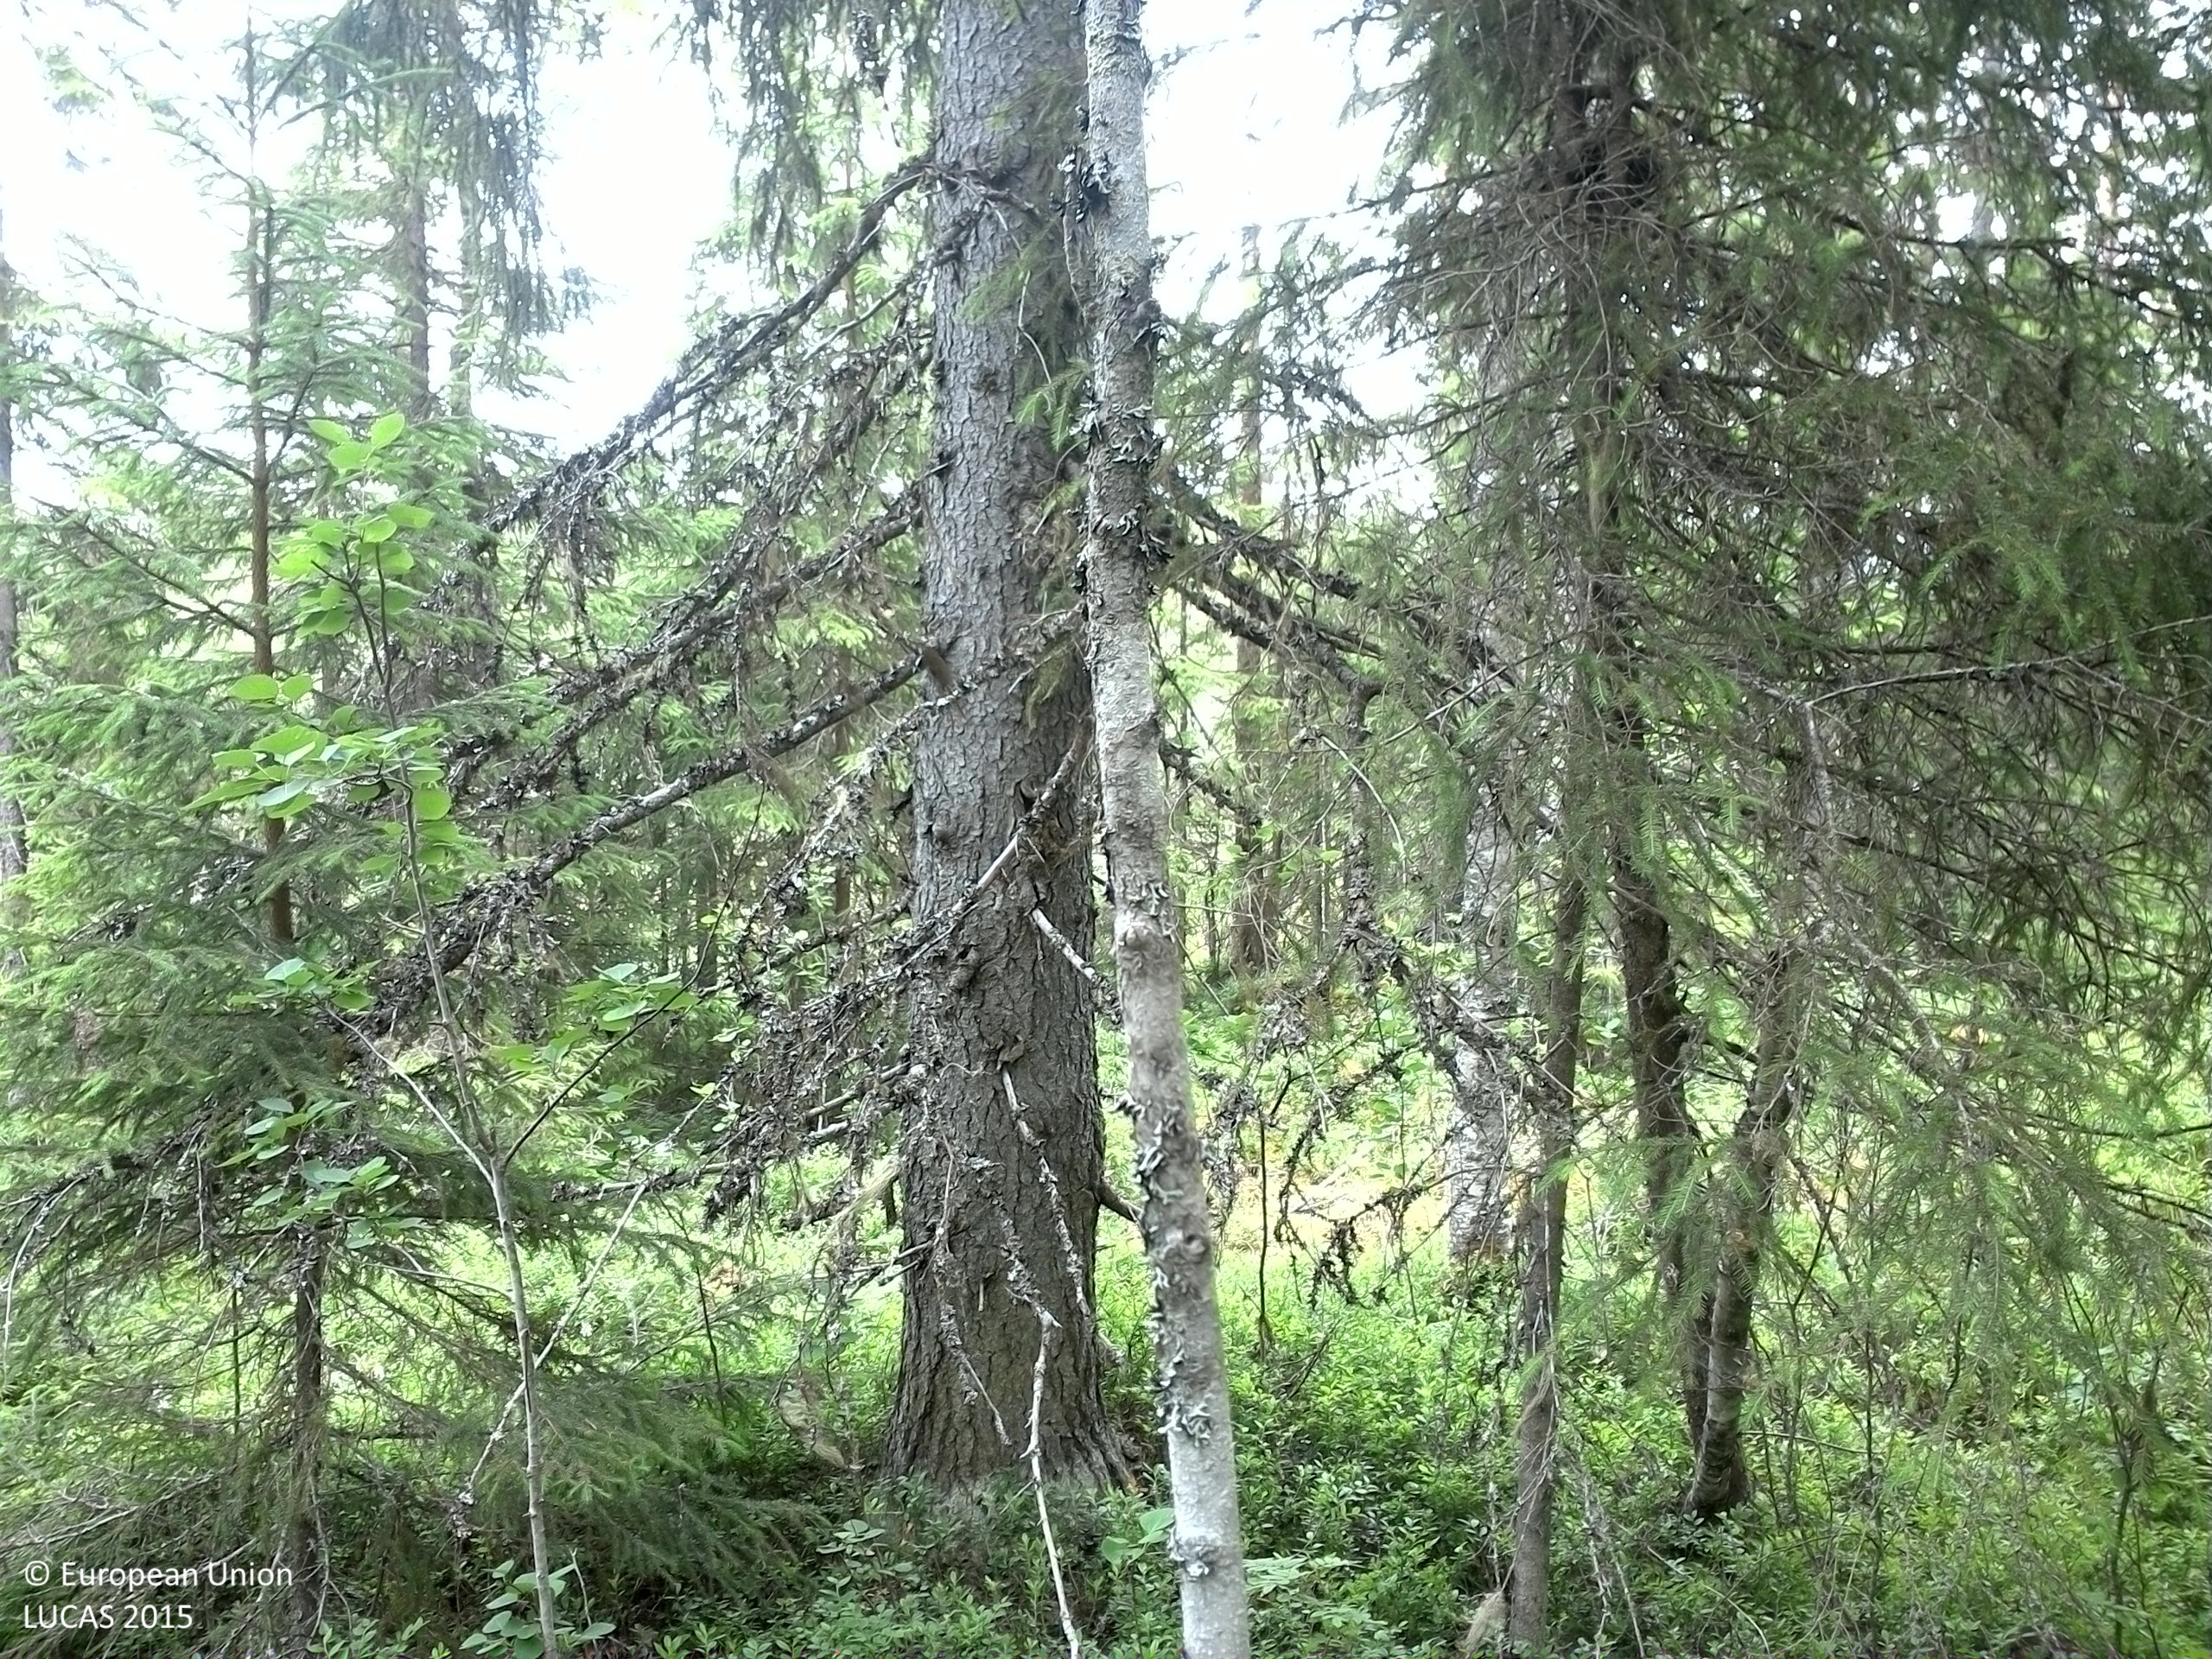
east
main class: Woodland
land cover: Spruce dominated mixed woodland
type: boreal forest
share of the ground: > 75 %
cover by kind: coniferous forest trees 60 %, broadleaved forest trees 20 %, shrubs 20 %
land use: Forestry
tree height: > 5 m
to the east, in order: Spruce dominated mixed woodland; Pine dominated mixed woodland; Inland fresh water bodies; Pine dominated mixed woodland
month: July
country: SE
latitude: 62.7622
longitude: 17.2833
